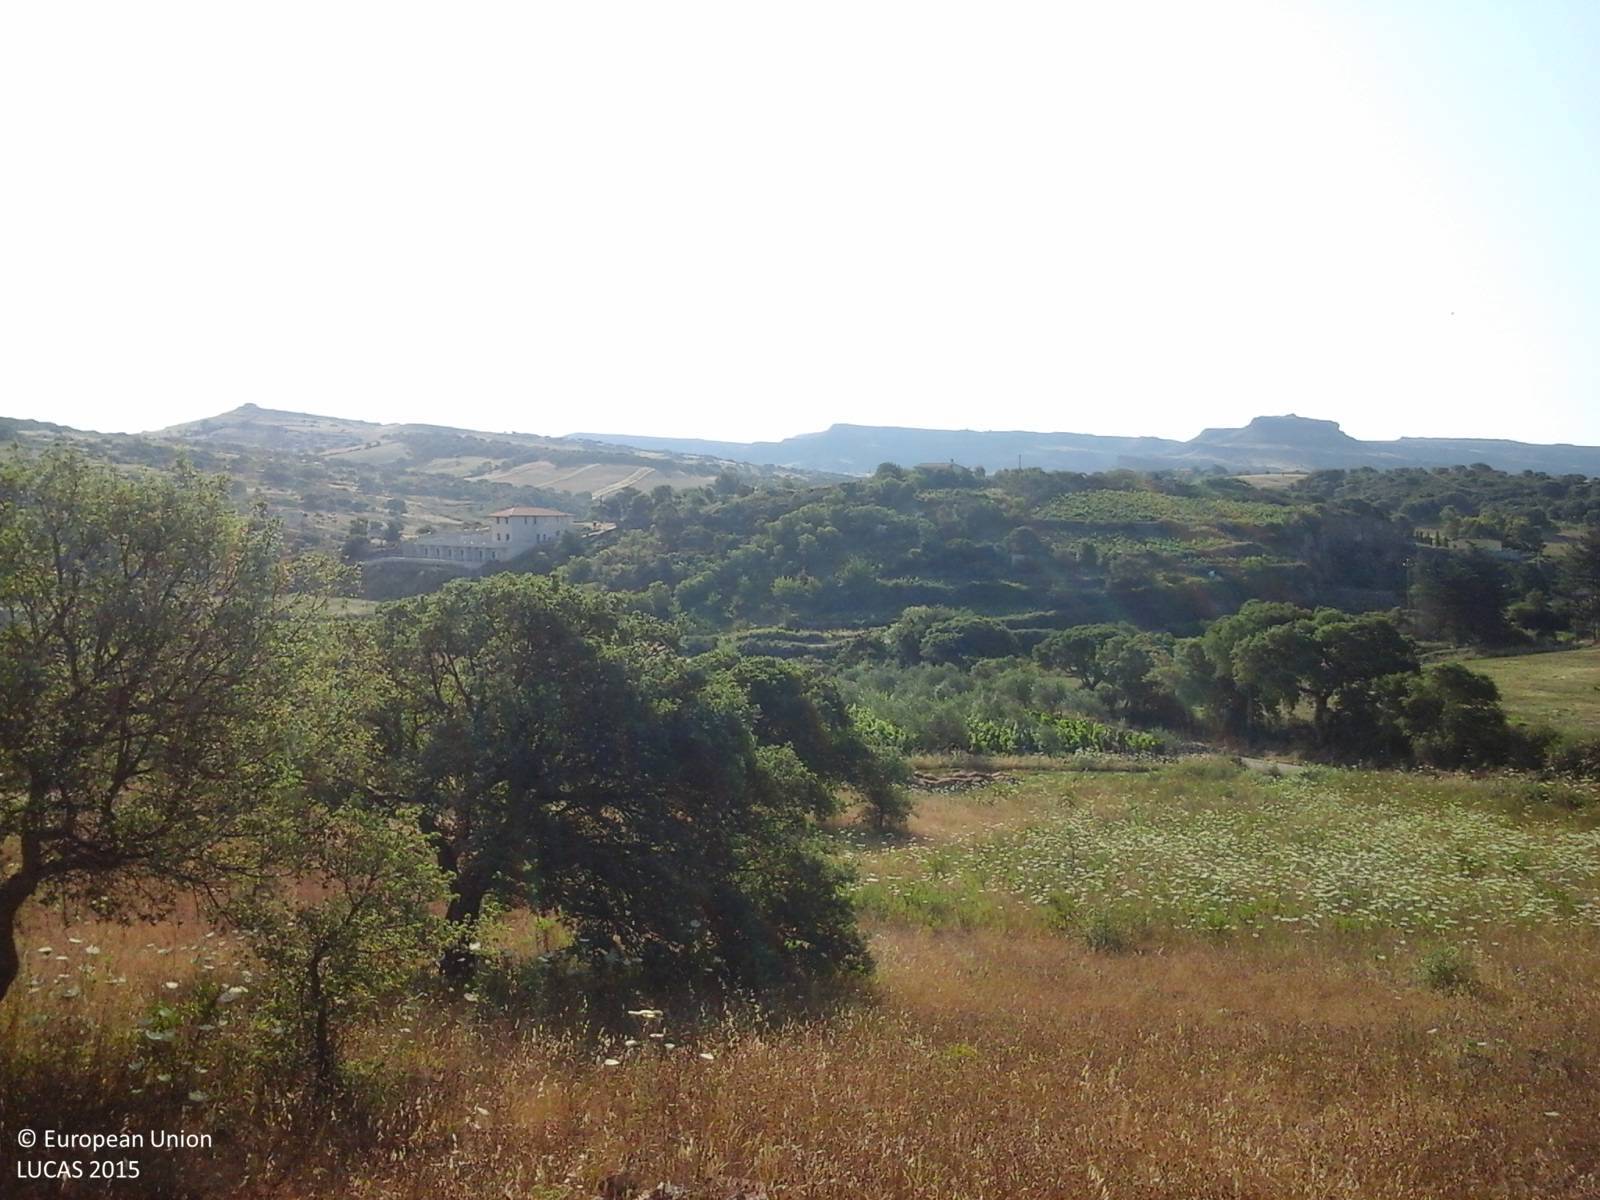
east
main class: Grassland
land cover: Grassland without tree/shrub cover
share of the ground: 50 - 75 %
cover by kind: herbaceous plants 100 %
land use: Agriculture (excluding fallow land and kitchen gardens)
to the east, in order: Grassland without tree/shrub cover; Single bushes/trees; Spontaneously vegetated surfaces; Single bushes/trees; Tracks; Dry stone walls; Fences; Vineyards; Other bare soil; Artificial constructions in urban areas; Grassland without tree/shrub cover; Electric lines; Abandoned hedges; Shrubland without tree cover
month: July
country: IT
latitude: 40.5648
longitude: 8.5779
